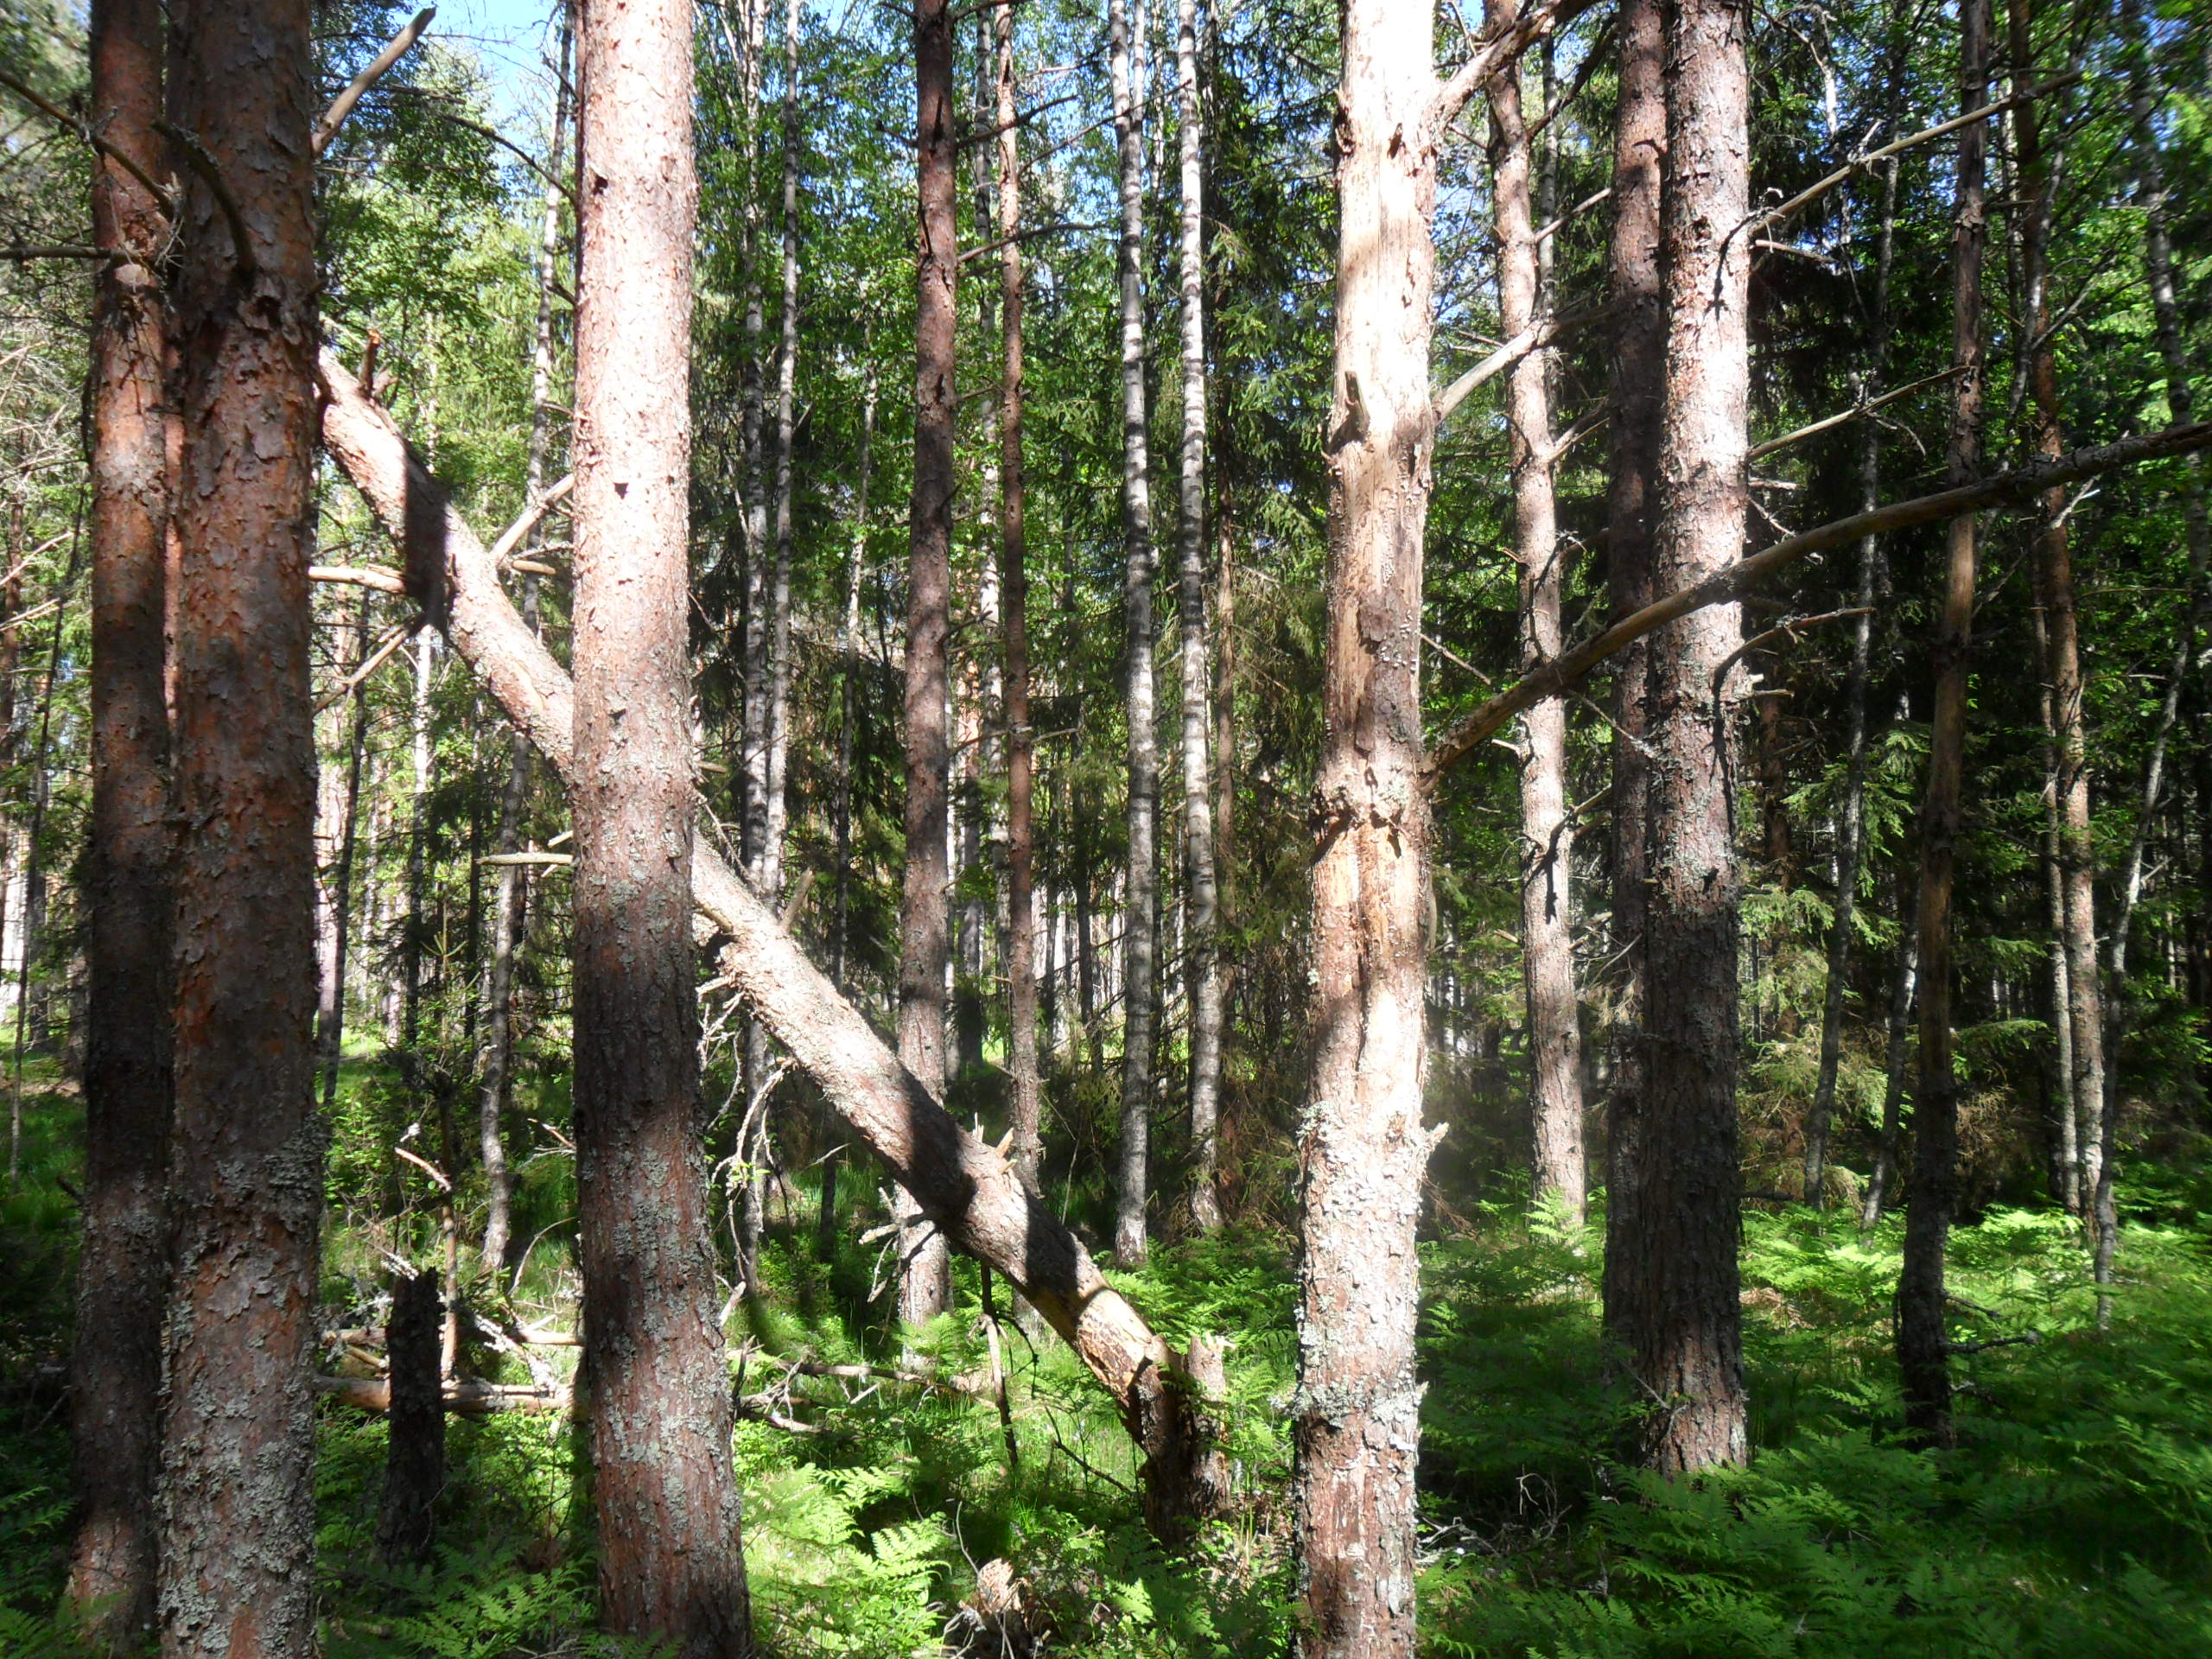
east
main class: Woodland
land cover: Pine dominated mixed woodland
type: hemiboreal forest and nemoral coniferous forest and mixed broadleaved-coniferous forest
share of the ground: > 75 %
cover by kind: coniferous forest trees 60 %, broadleaved forest trees 20 %, herbaceous plants 20 %
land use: Forestry
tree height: > 5 m
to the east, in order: Pine dominated mixed woodland; Pine dominated coniferous woodland; Spruce dominated mixed woodland
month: June
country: LV
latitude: 57.5253
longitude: 22.2895
